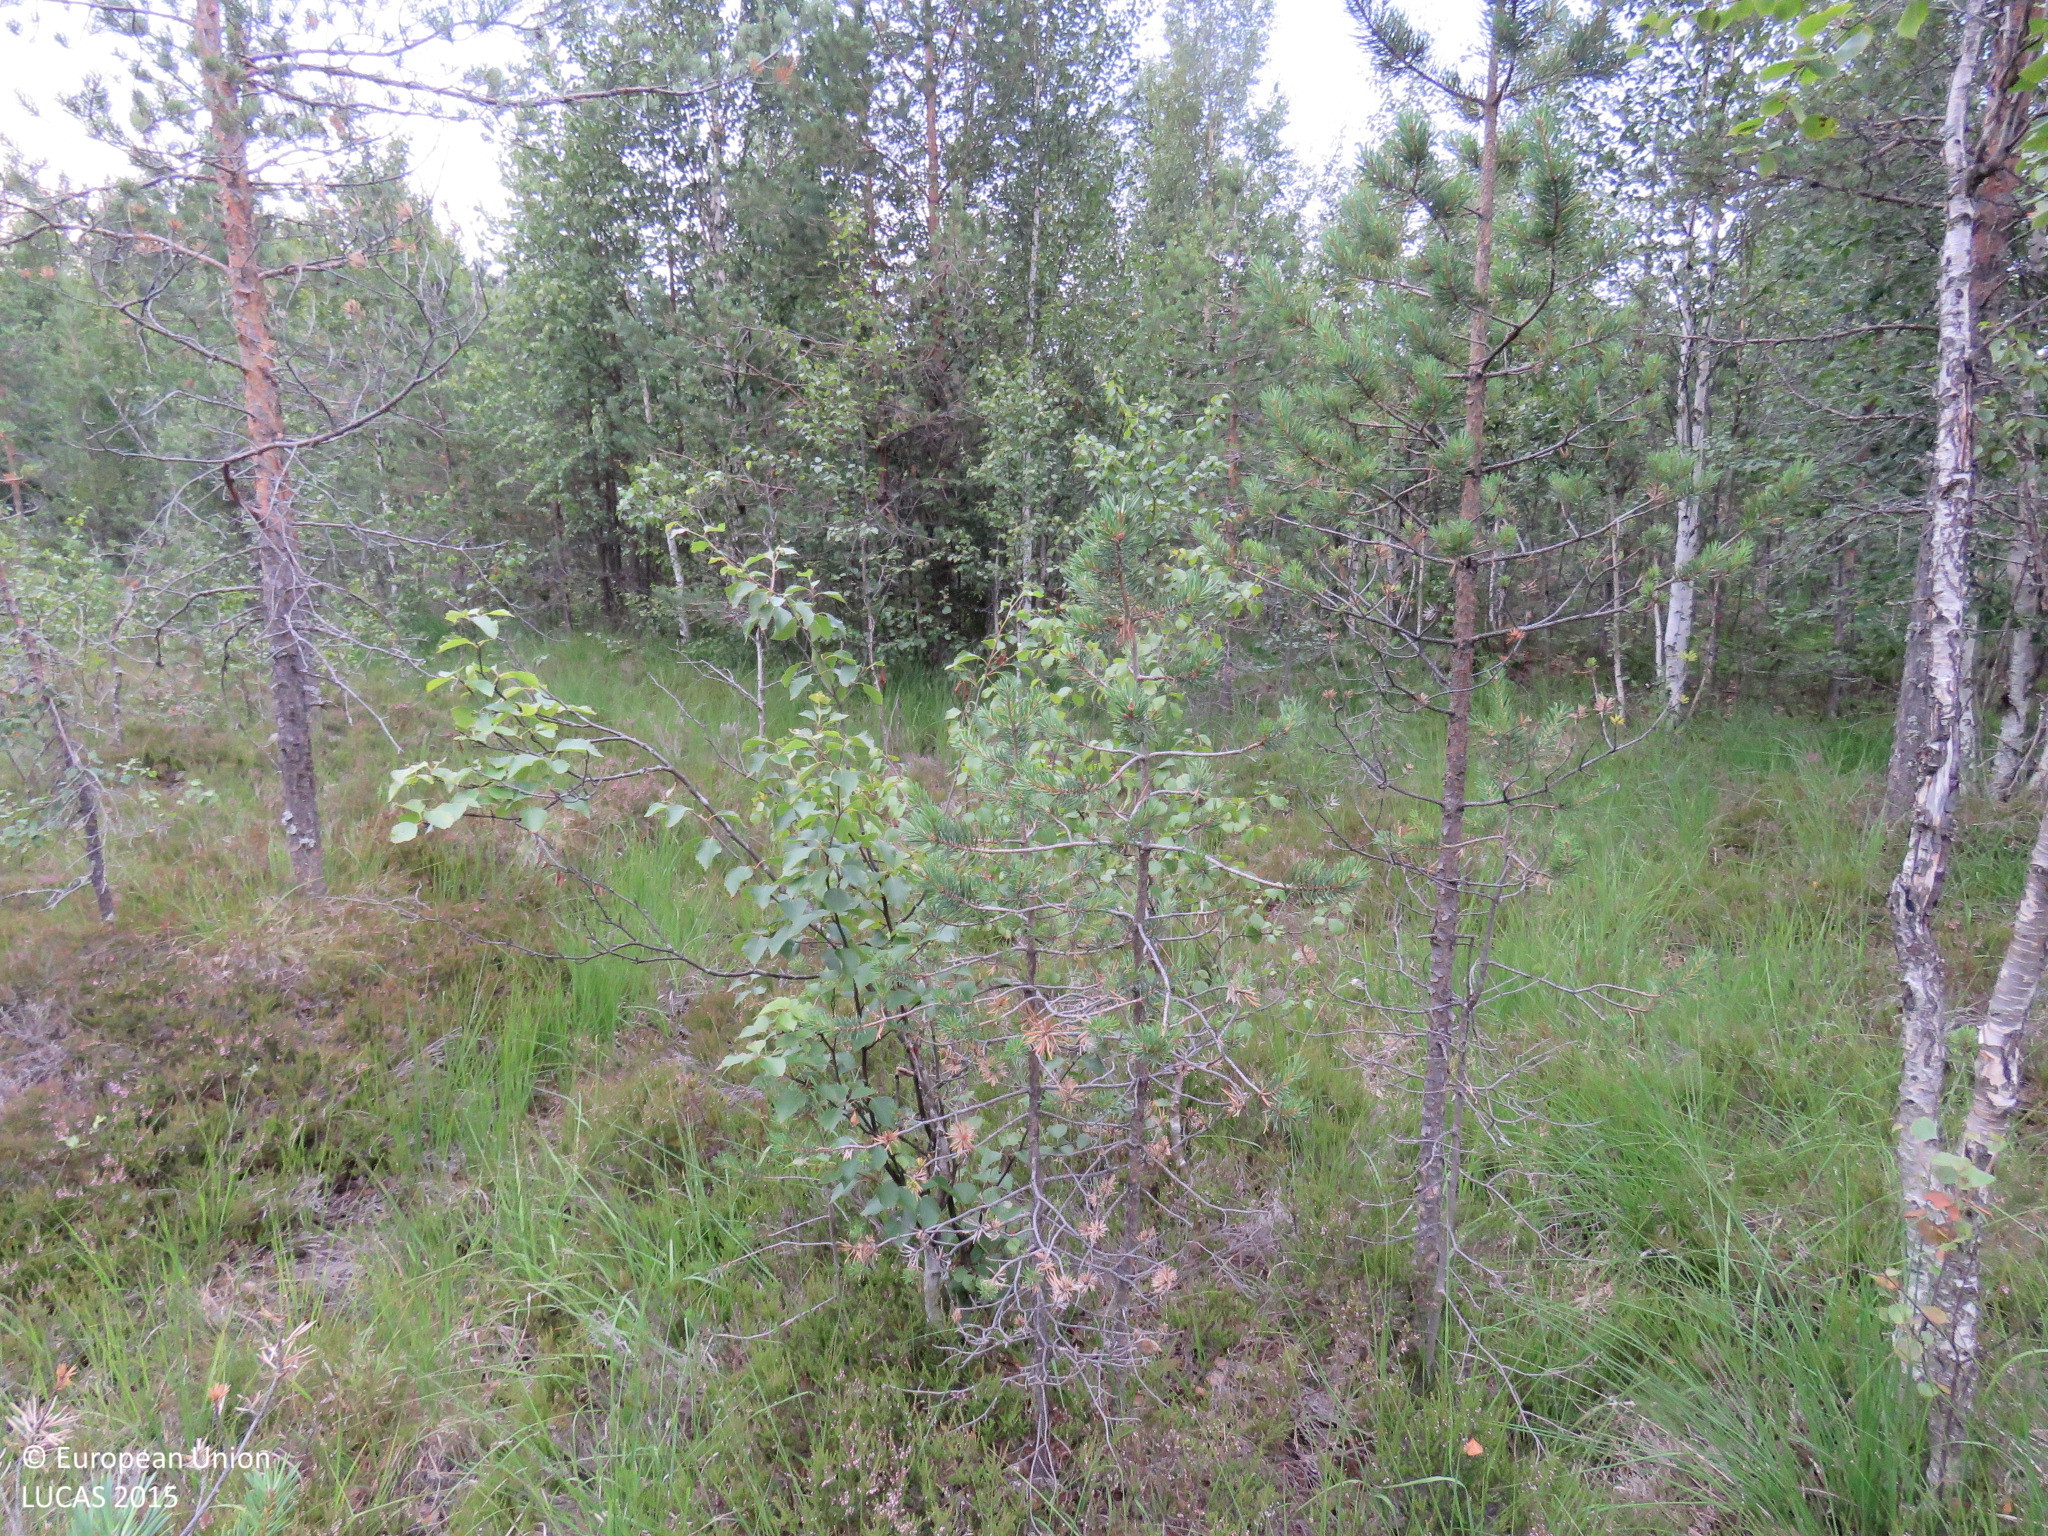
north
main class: Woodland
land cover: Pine dominated mixed woodland
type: mire and swamp forests
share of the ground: > 75 %
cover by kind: broadleaved forest trees 45 %, coniferous forest trees 30 %, shrubs 15 %, herbaceous plants 10 %
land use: Forestry
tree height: > 5 m
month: July
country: FI
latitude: 64.6914
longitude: 26.8734
